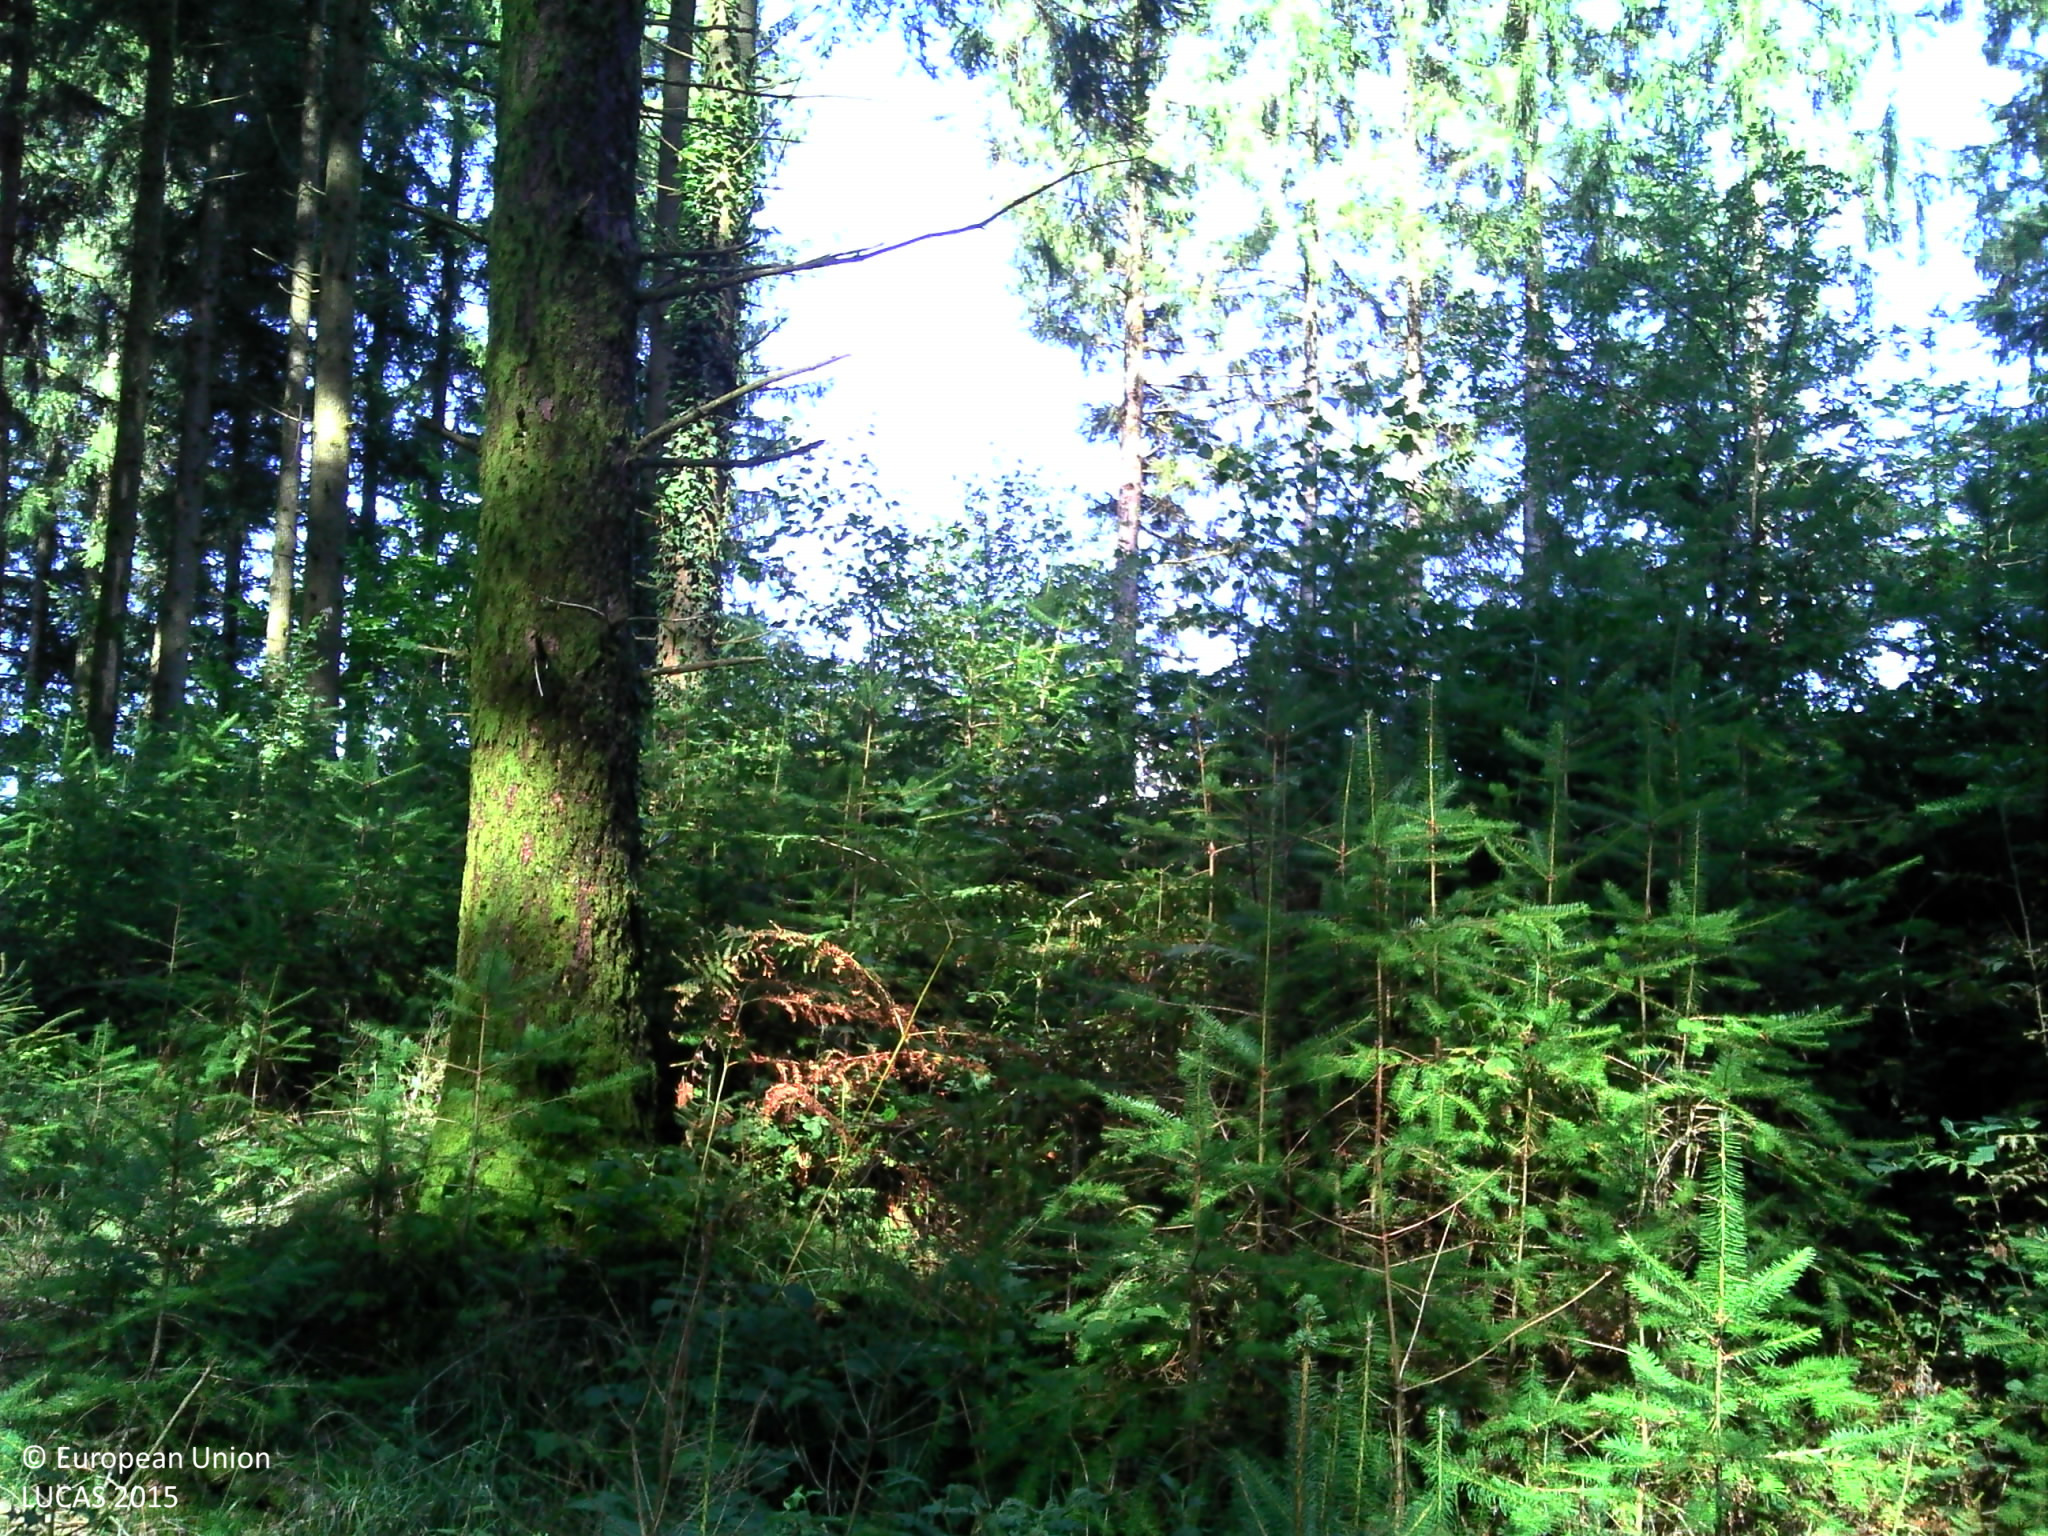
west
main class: Woodland
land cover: Other coniferous woodland
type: exotic forest
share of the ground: > 75 %
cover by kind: coniferous forest trees 65 %, herbaceous plants 35 %
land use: Forestry
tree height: > 5 m
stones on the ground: < 10 %
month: August
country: FR
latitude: 45.6554
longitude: 1.7943
